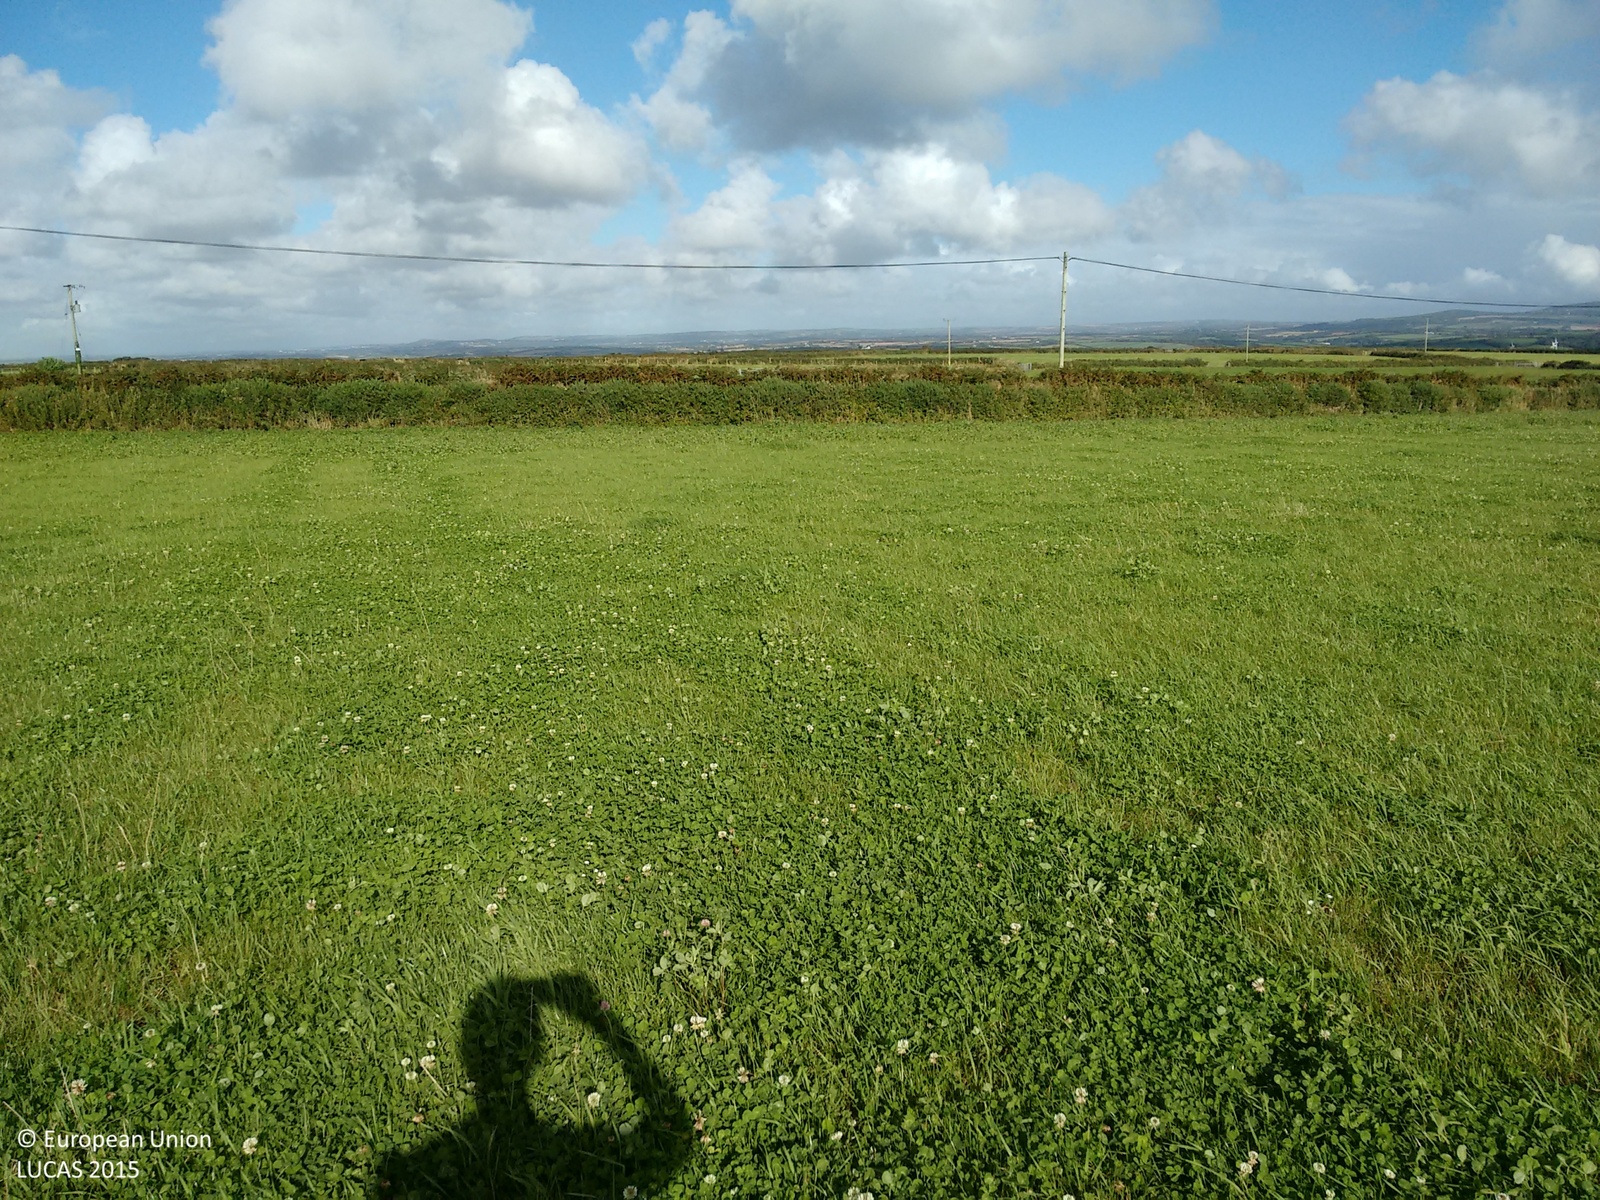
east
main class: Cropland
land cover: Clovers
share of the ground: > 75 %
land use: Agriculture (excluding fallow land and kitchen gardens)
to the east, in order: Clovers; Managed hedges; Artificial constructions; Tracks; Electric lines; Managed hedges; Artificial constructions; Fences; Grass margins; Other fresh vegetables; Lucerne; Grass margins; Fences; Managed hedges; Artificial constructions; Grassland without tree/shrub cover; Electric lines; Grassland without tree/shrub cover; Managed hedges; Artificial constructions; Fences; Grassland without tree/shrub cover
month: August
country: GB
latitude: 50.1619
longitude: -5.4834
